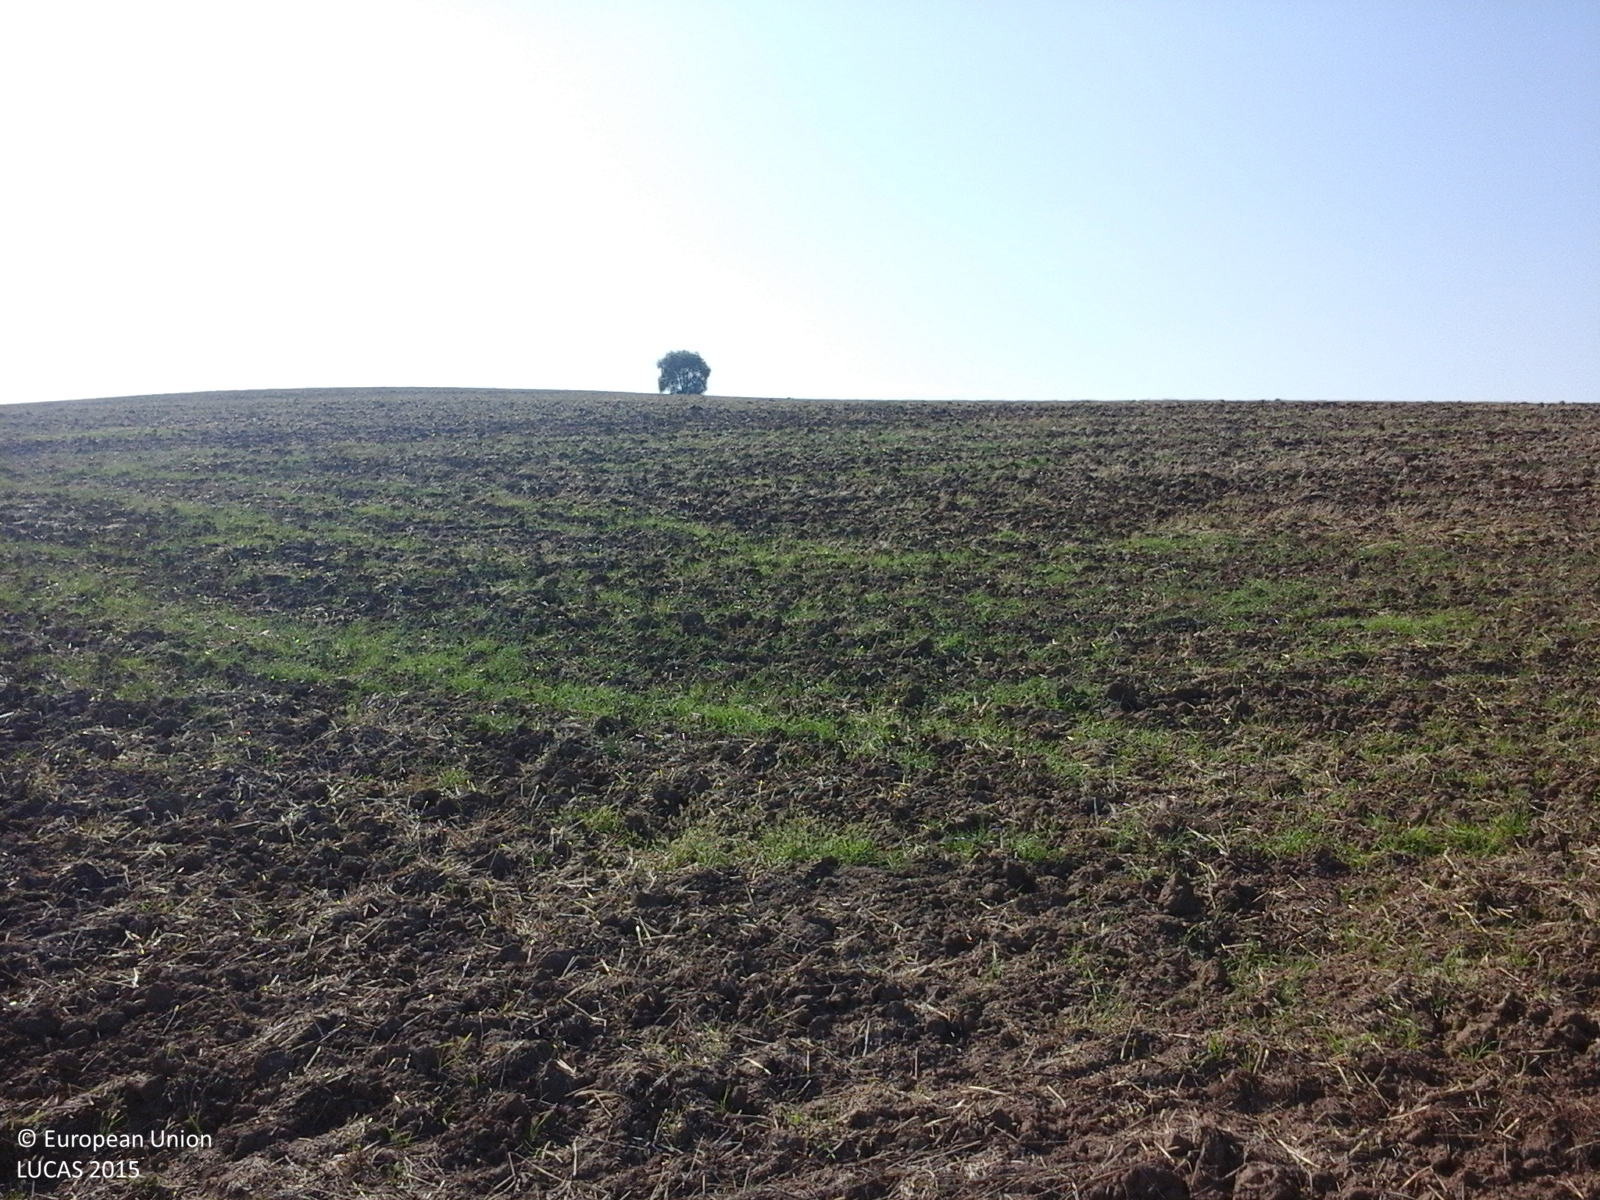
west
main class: Grassland
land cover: Spontaneously vegetated surfaces
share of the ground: 10 - 25 %
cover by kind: herbaceous plants 100 %
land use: Fallow land
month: September
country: RO
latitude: 47.2899
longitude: 22.6596
